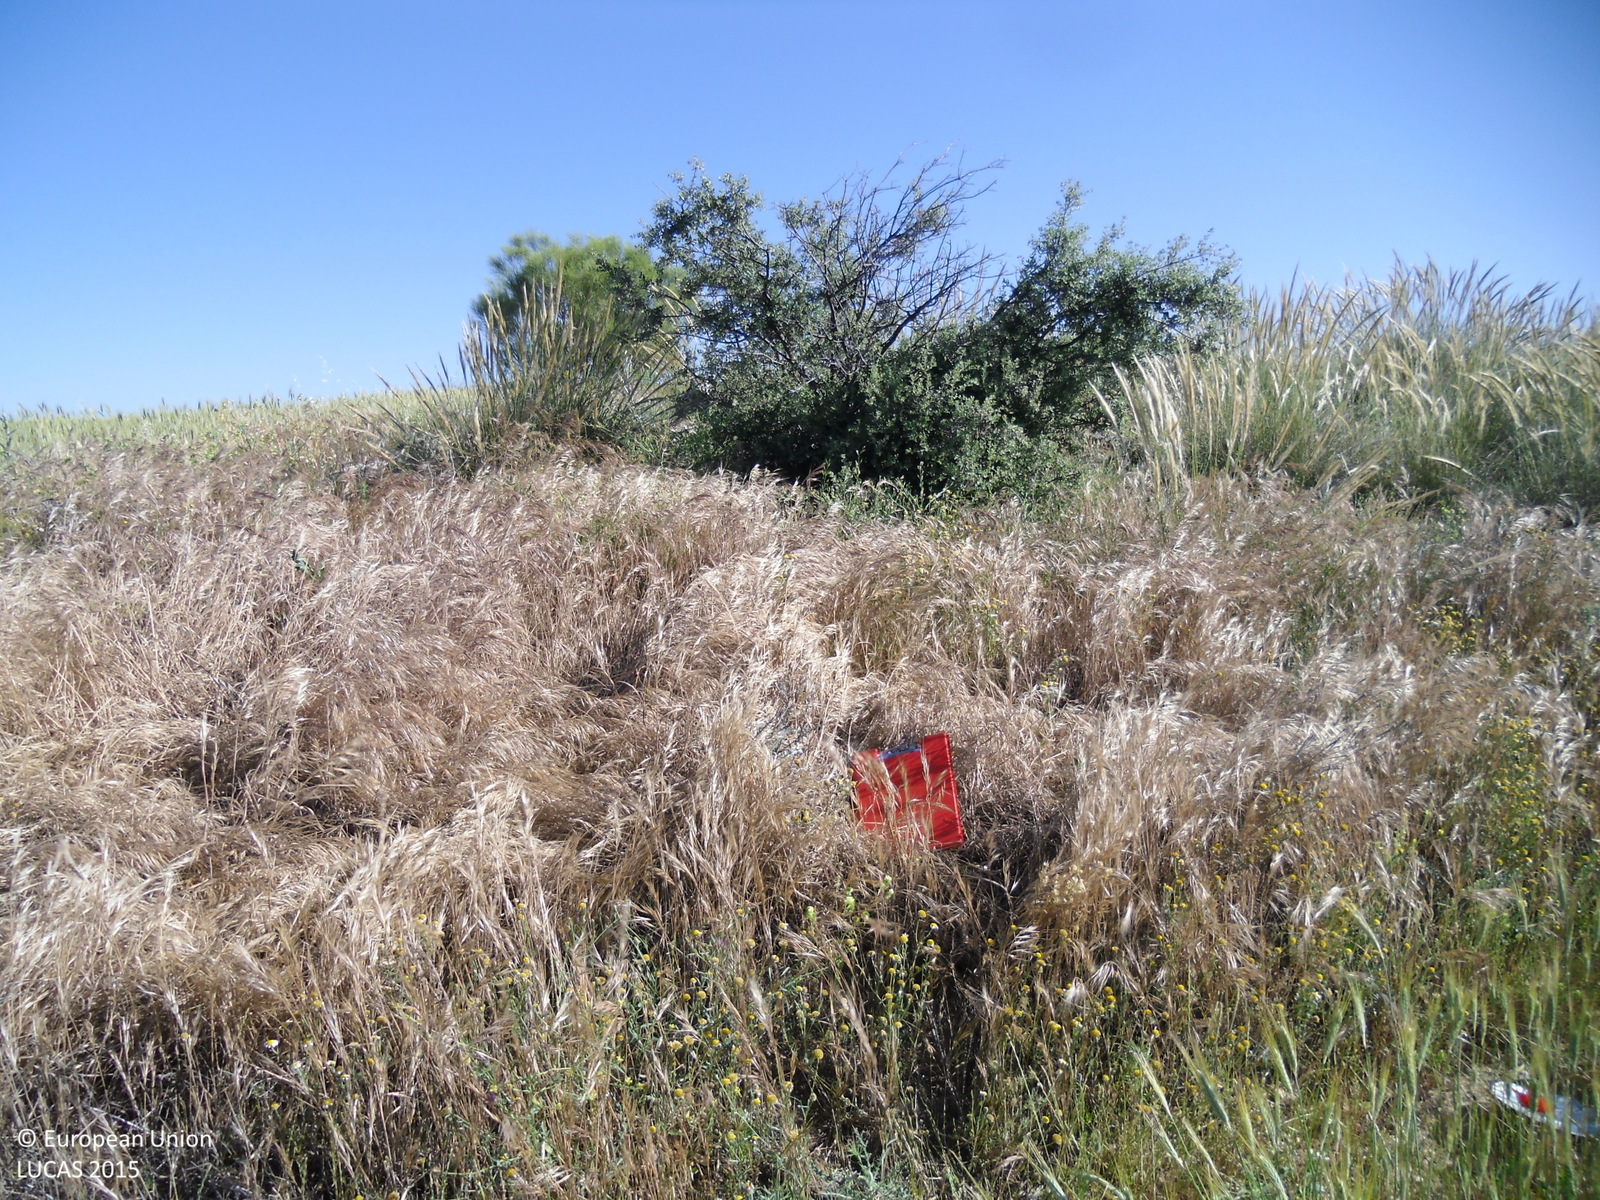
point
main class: Shrubland
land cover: Shrubland without tree cover
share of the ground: 25 - 50 %
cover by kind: herbaceous plants 70 %, shrubs 30 %
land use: Semi-natural and natural areas not in use
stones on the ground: < 10 %
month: May
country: ES
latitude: 40.3069
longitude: -2.9103
